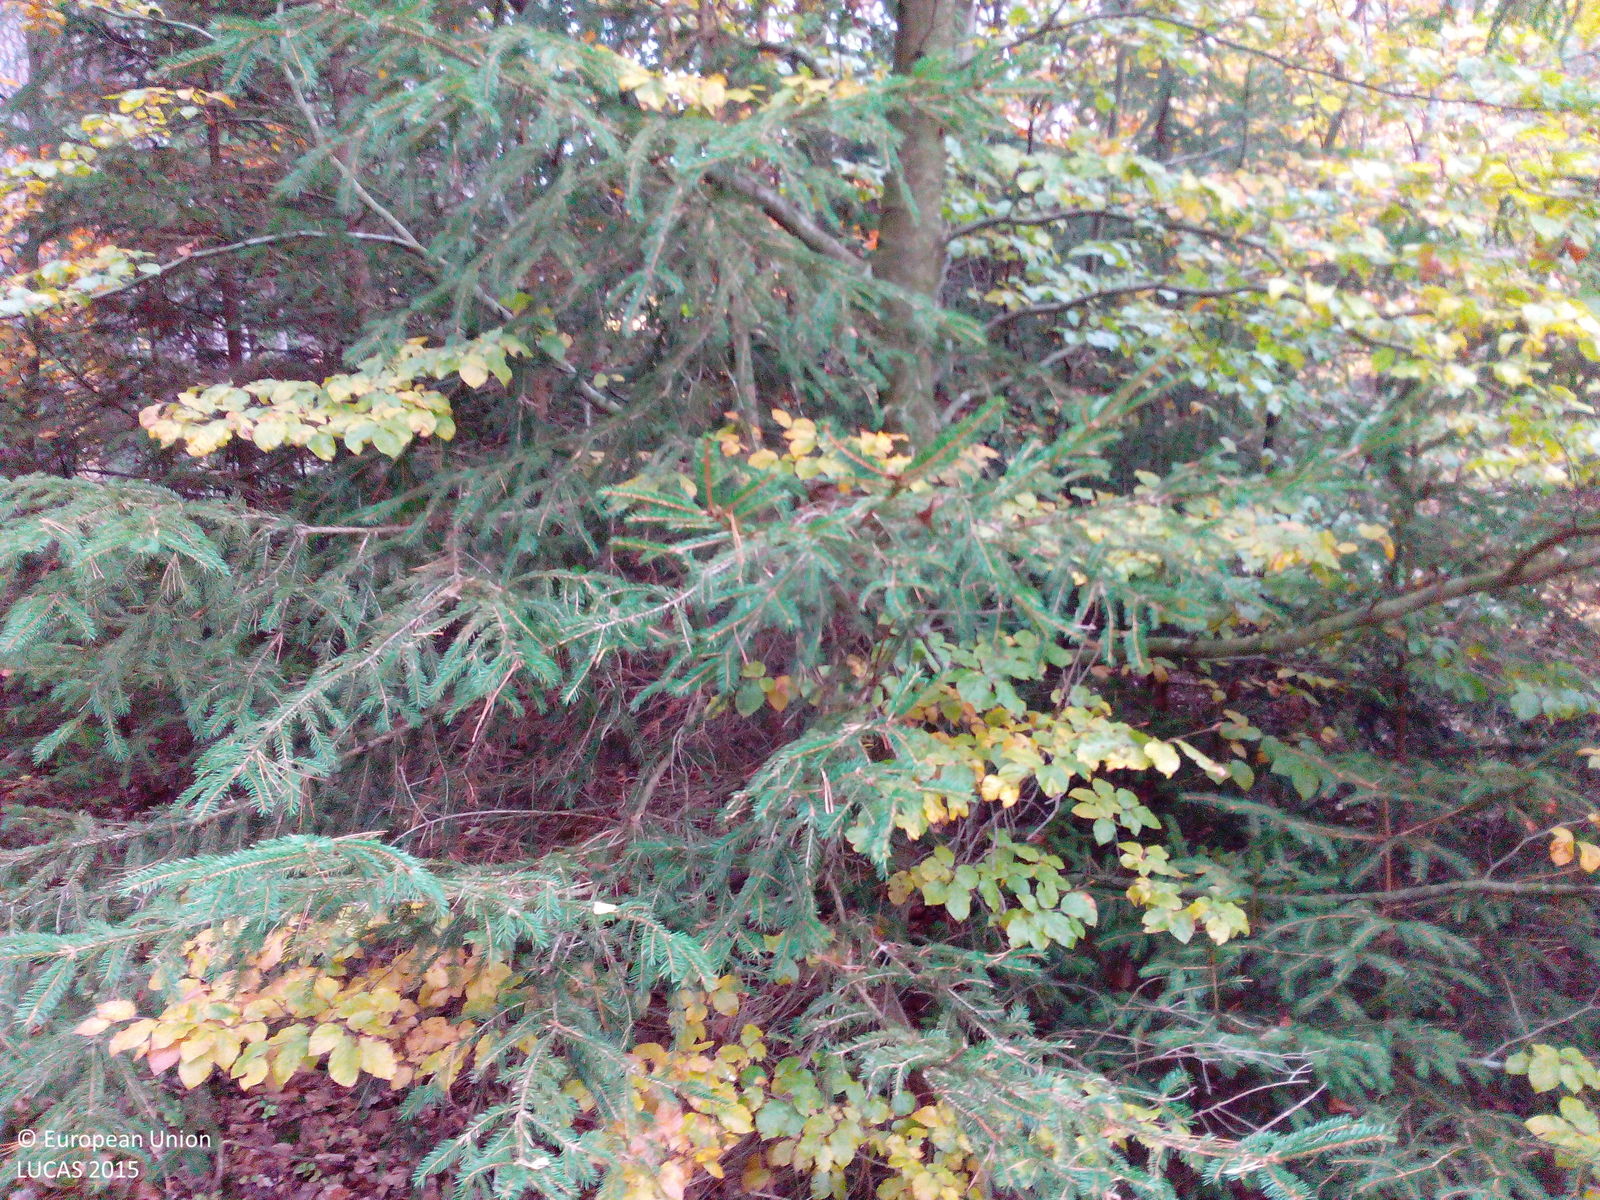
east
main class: Woodland
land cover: Other mixed woodland
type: hemiboreal forest and nemoral coniferous forest and mixed broadleaved-coniferous forest
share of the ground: > 75 %
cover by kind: coniferous forest trees 50 %, broadleaved forest trees 30 %, shrubs 10 %, unconsolidated bare surface 10 %
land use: Forestry
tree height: > 5 m
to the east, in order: Other mixed woodland; Tracks; Other mixed woodland; Tracks; Broadleaved woodland
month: October
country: DE
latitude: 50.2022
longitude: 9.9020
